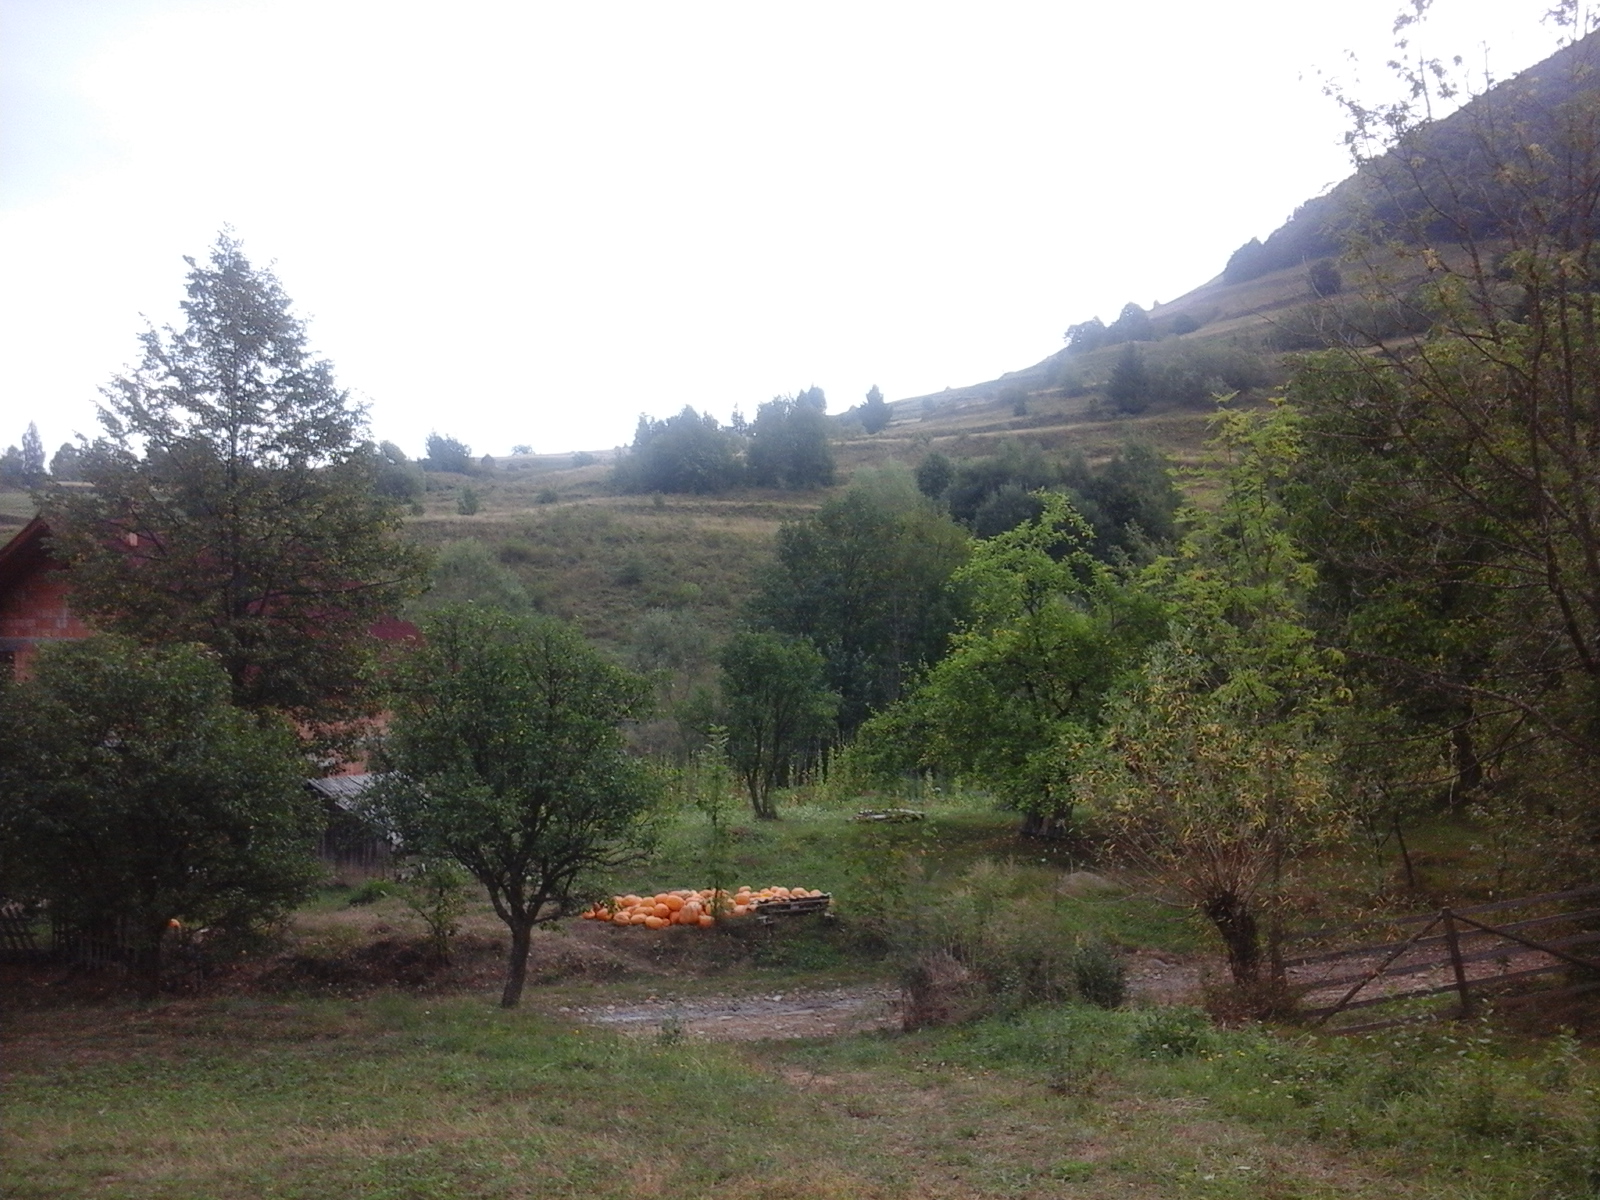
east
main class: Grassland
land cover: Grassland without tree/shrub cover
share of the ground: > 75 %
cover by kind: herbaceous plants 100 %
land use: Agriculture (excluding fallow land and kitchen gardens)
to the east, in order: Grassland without tree/shrub cover; Ditches and canals; Tracks; Grassland with sparse tree/shrub cover; Dry pulses; Grassland with sparse tree/shrub cover; Abandoned hedges; Rivers and streams; Abandoned hedges; Spontaneously vegetated surfaces
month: September
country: RO
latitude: 47.7174
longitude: 24.0693
